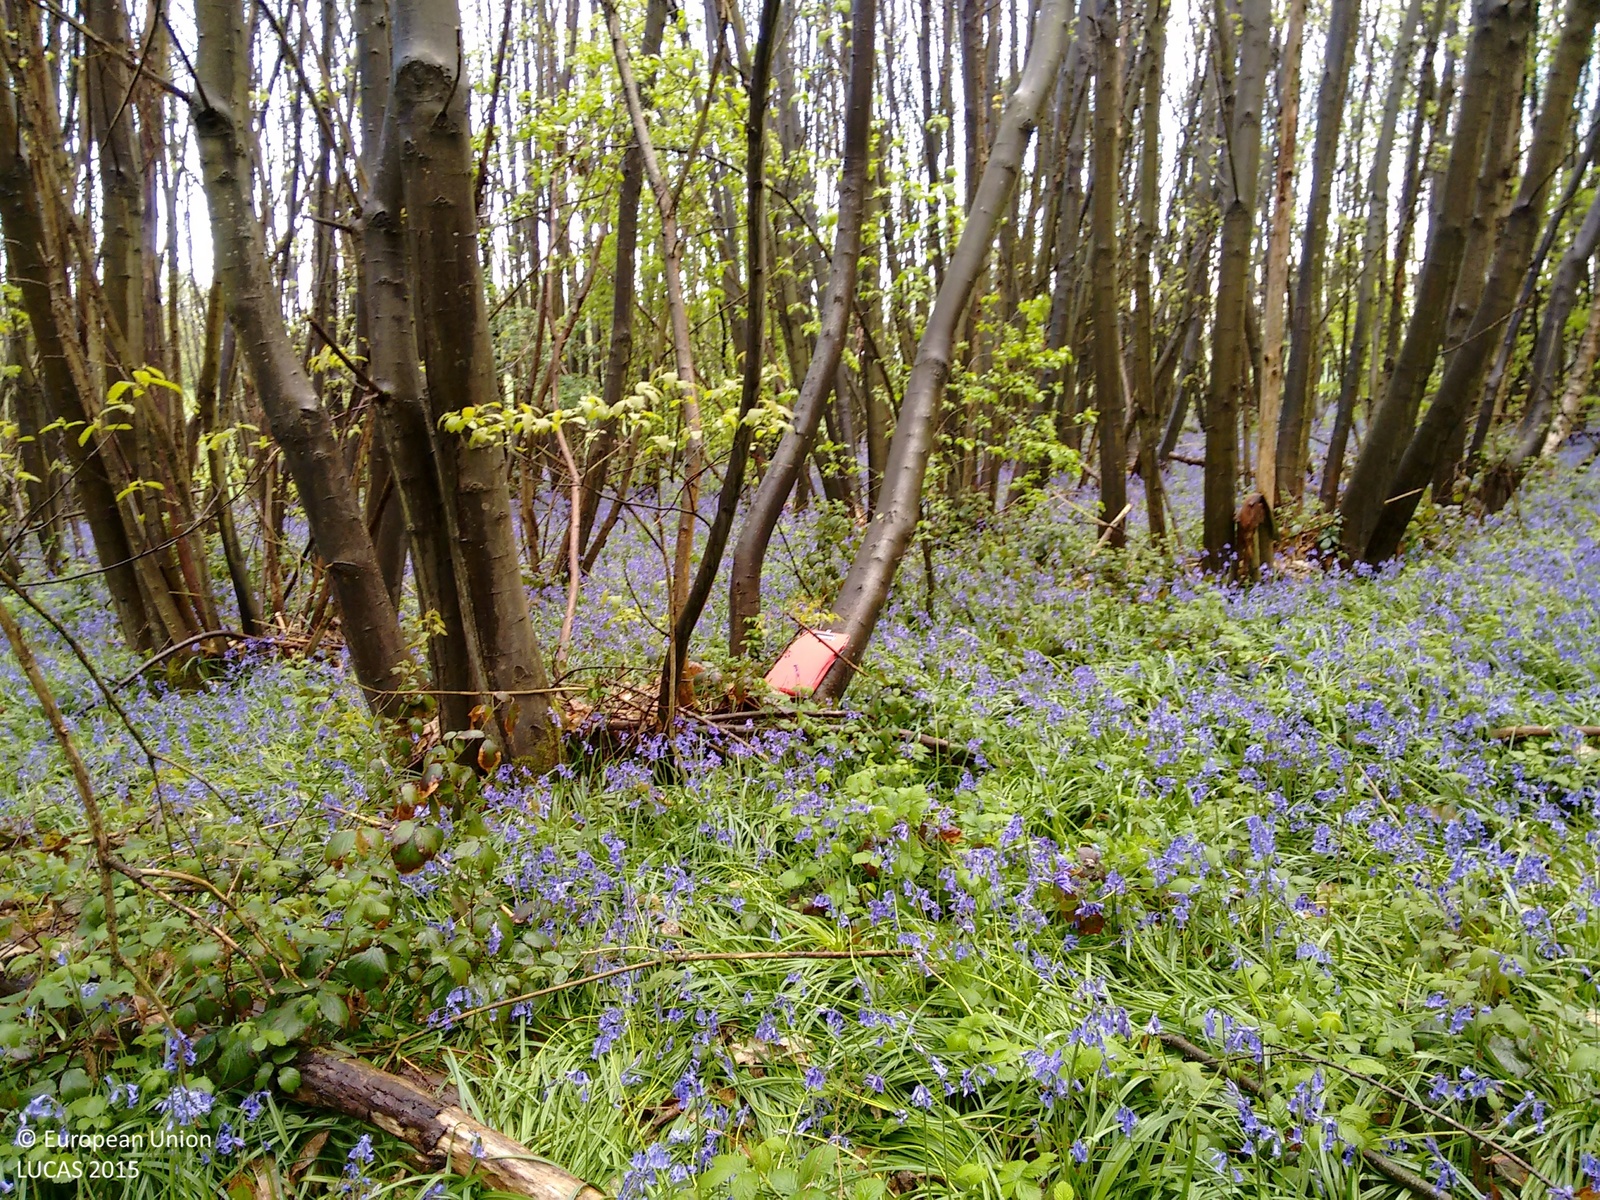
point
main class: Woodland
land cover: Broadleaved woodland
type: mesophytic deciduous forest
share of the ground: > 75 %
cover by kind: broadleaved forest trees 100 %
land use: Forestry
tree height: > 5 m
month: May
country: GB
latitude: 51.3212
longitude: 0.2263
